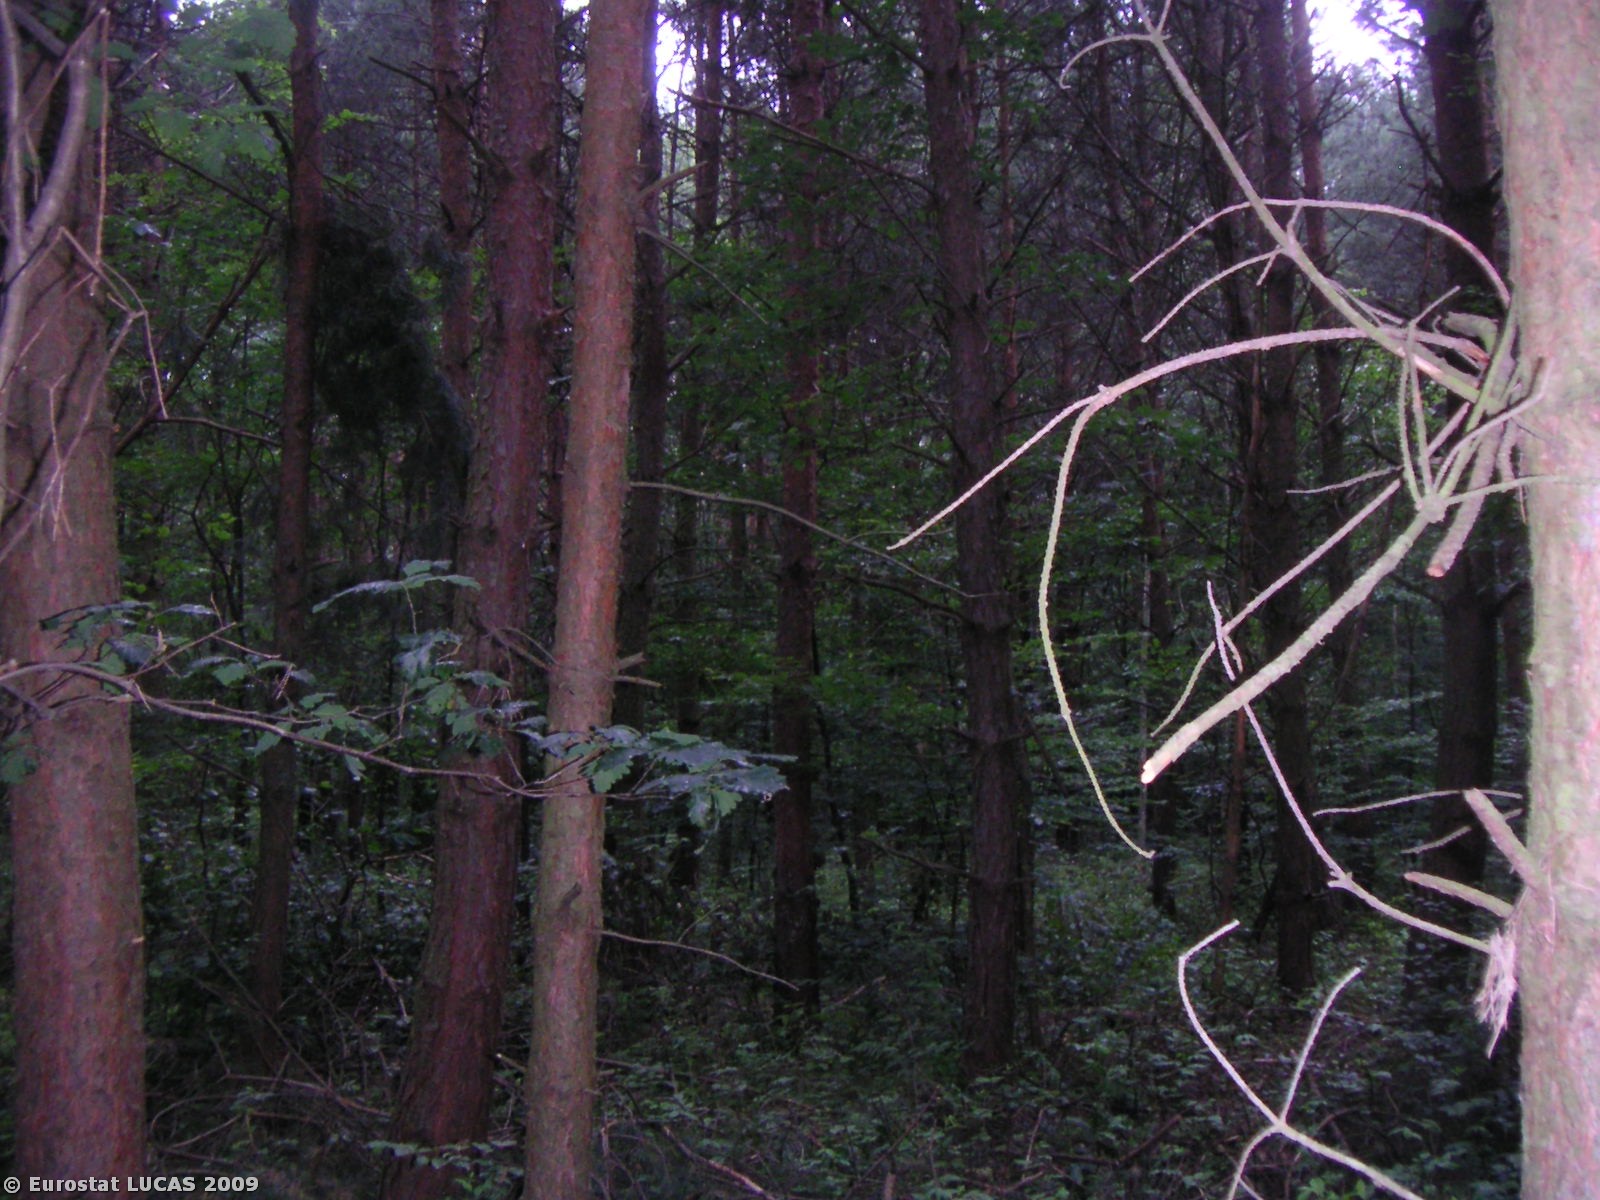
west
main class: Woodland
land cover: Coniferous woodland
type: hemiboreal forest and nemoral coniferous forest and mixed broadleaved-coniferous forest
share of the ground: > 75 %
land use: Forestry
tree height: > 5 m
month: July
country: PL
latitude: 50.5441
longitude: 19.7529
